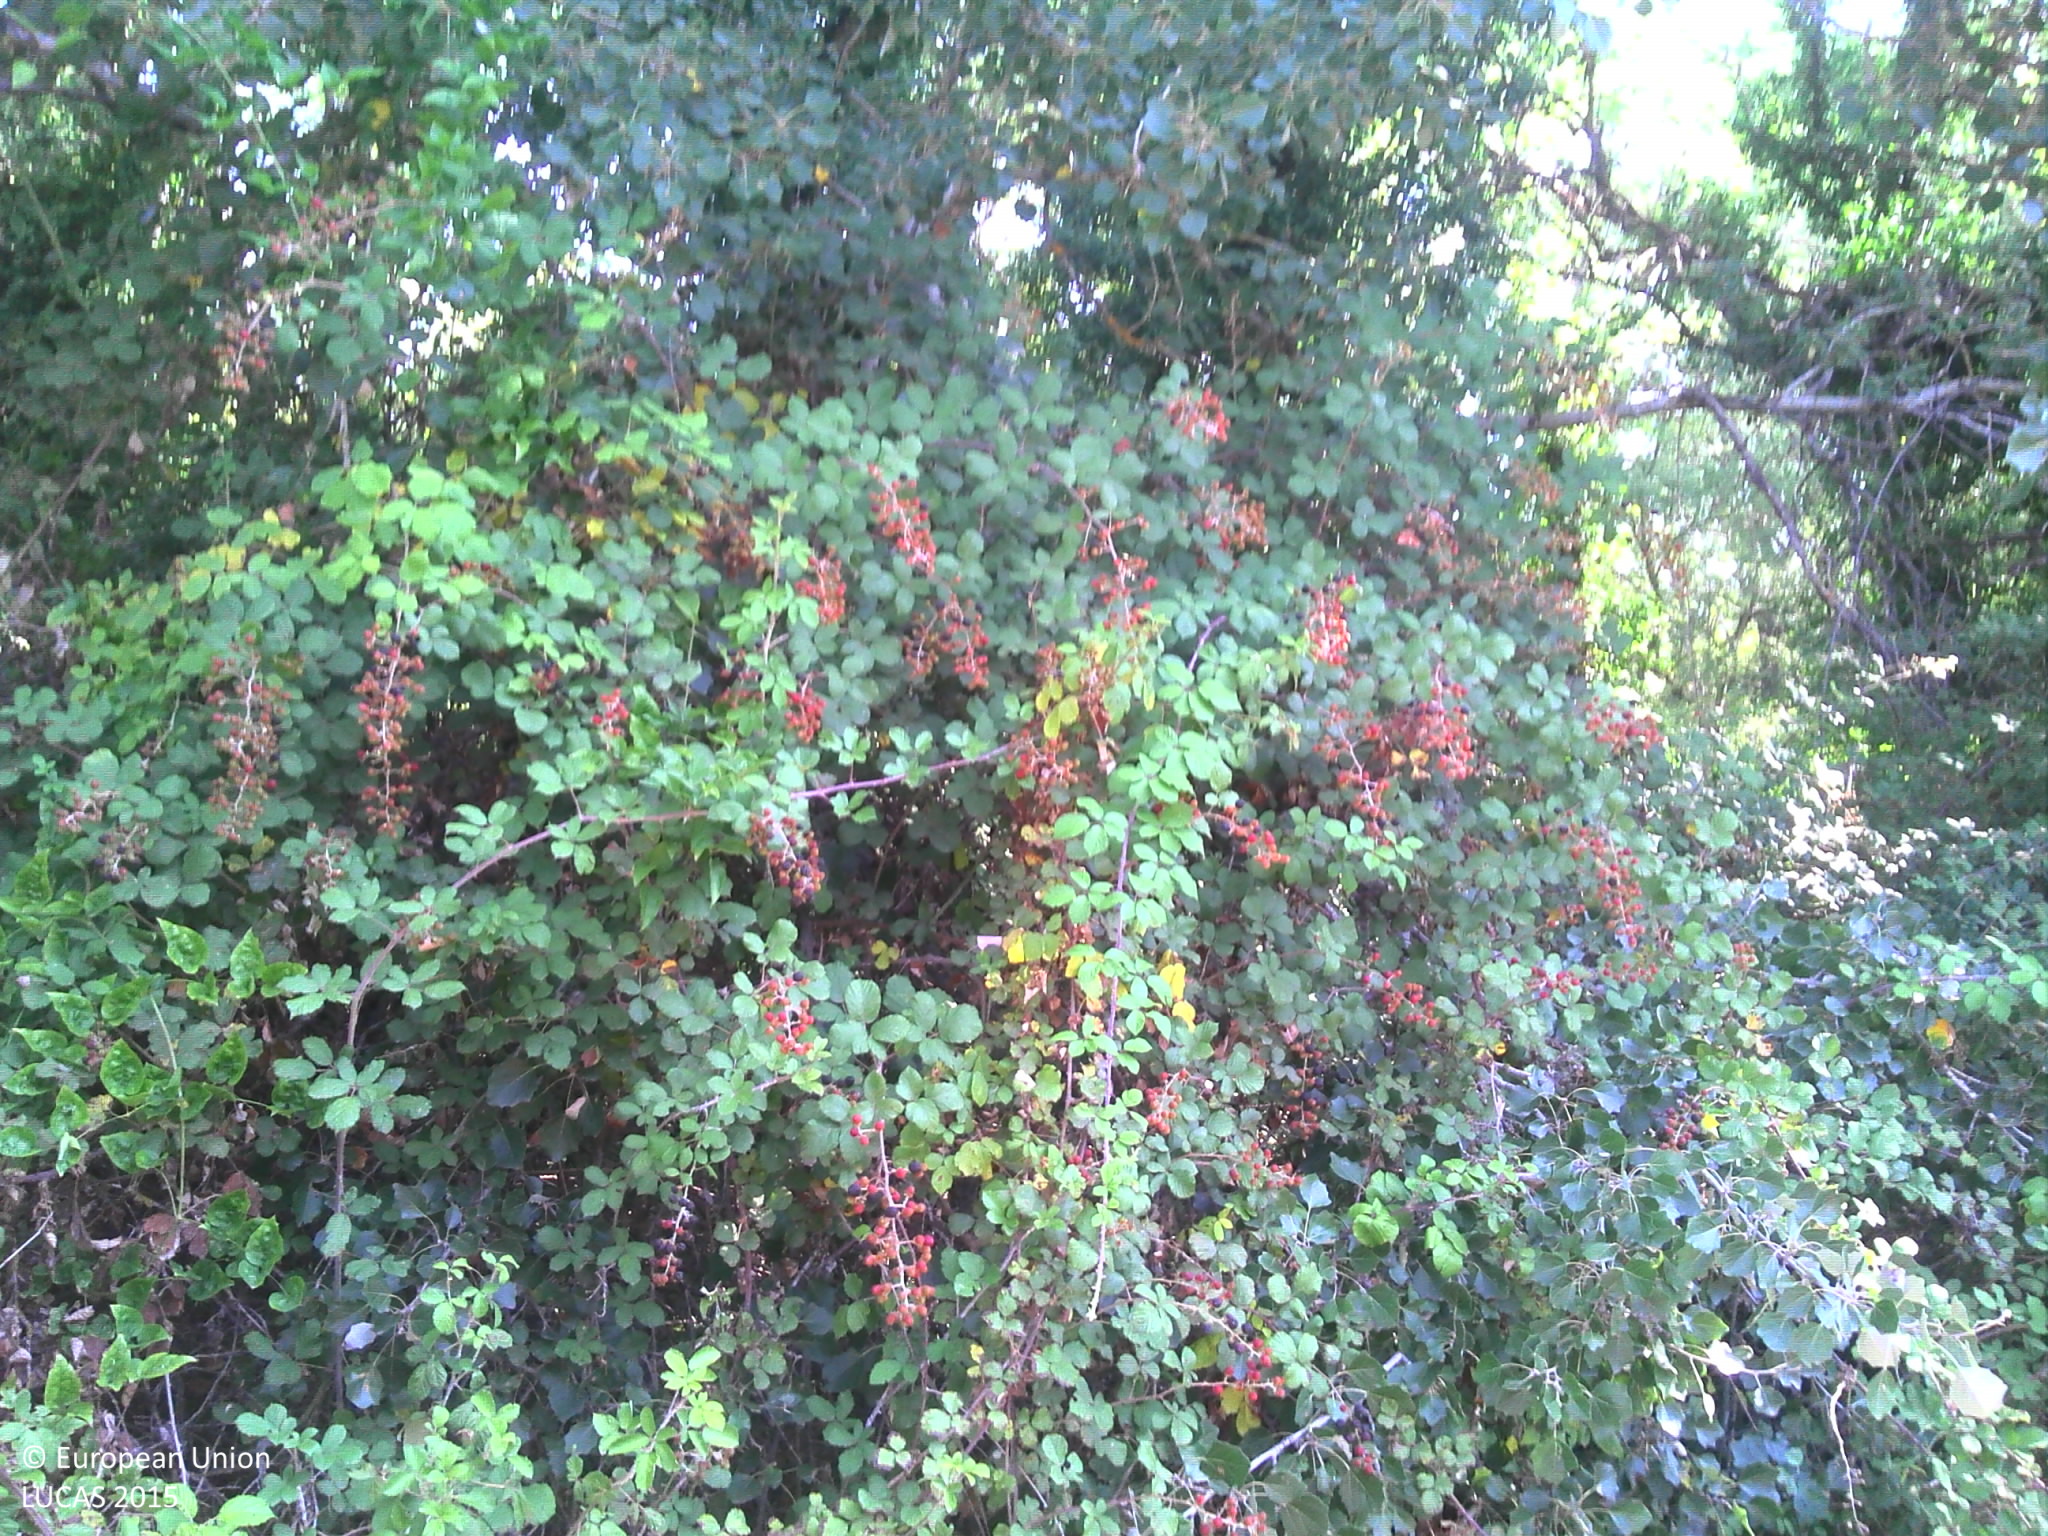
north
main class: Woodland
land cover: Broadleaved woodland
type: thermophilous deciduous forest
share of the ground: > 75 %
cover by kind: broadleaved forest trees 60 %, unconsolidated bare surface 20 %, shrubs 10 %, coniferous forest trees 5 %, herbaceous plants 5 %
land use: Semi-natural and natural areas not in use
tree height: > 5 m
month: August
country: FR
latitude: 43.6593
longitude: 5.5576
